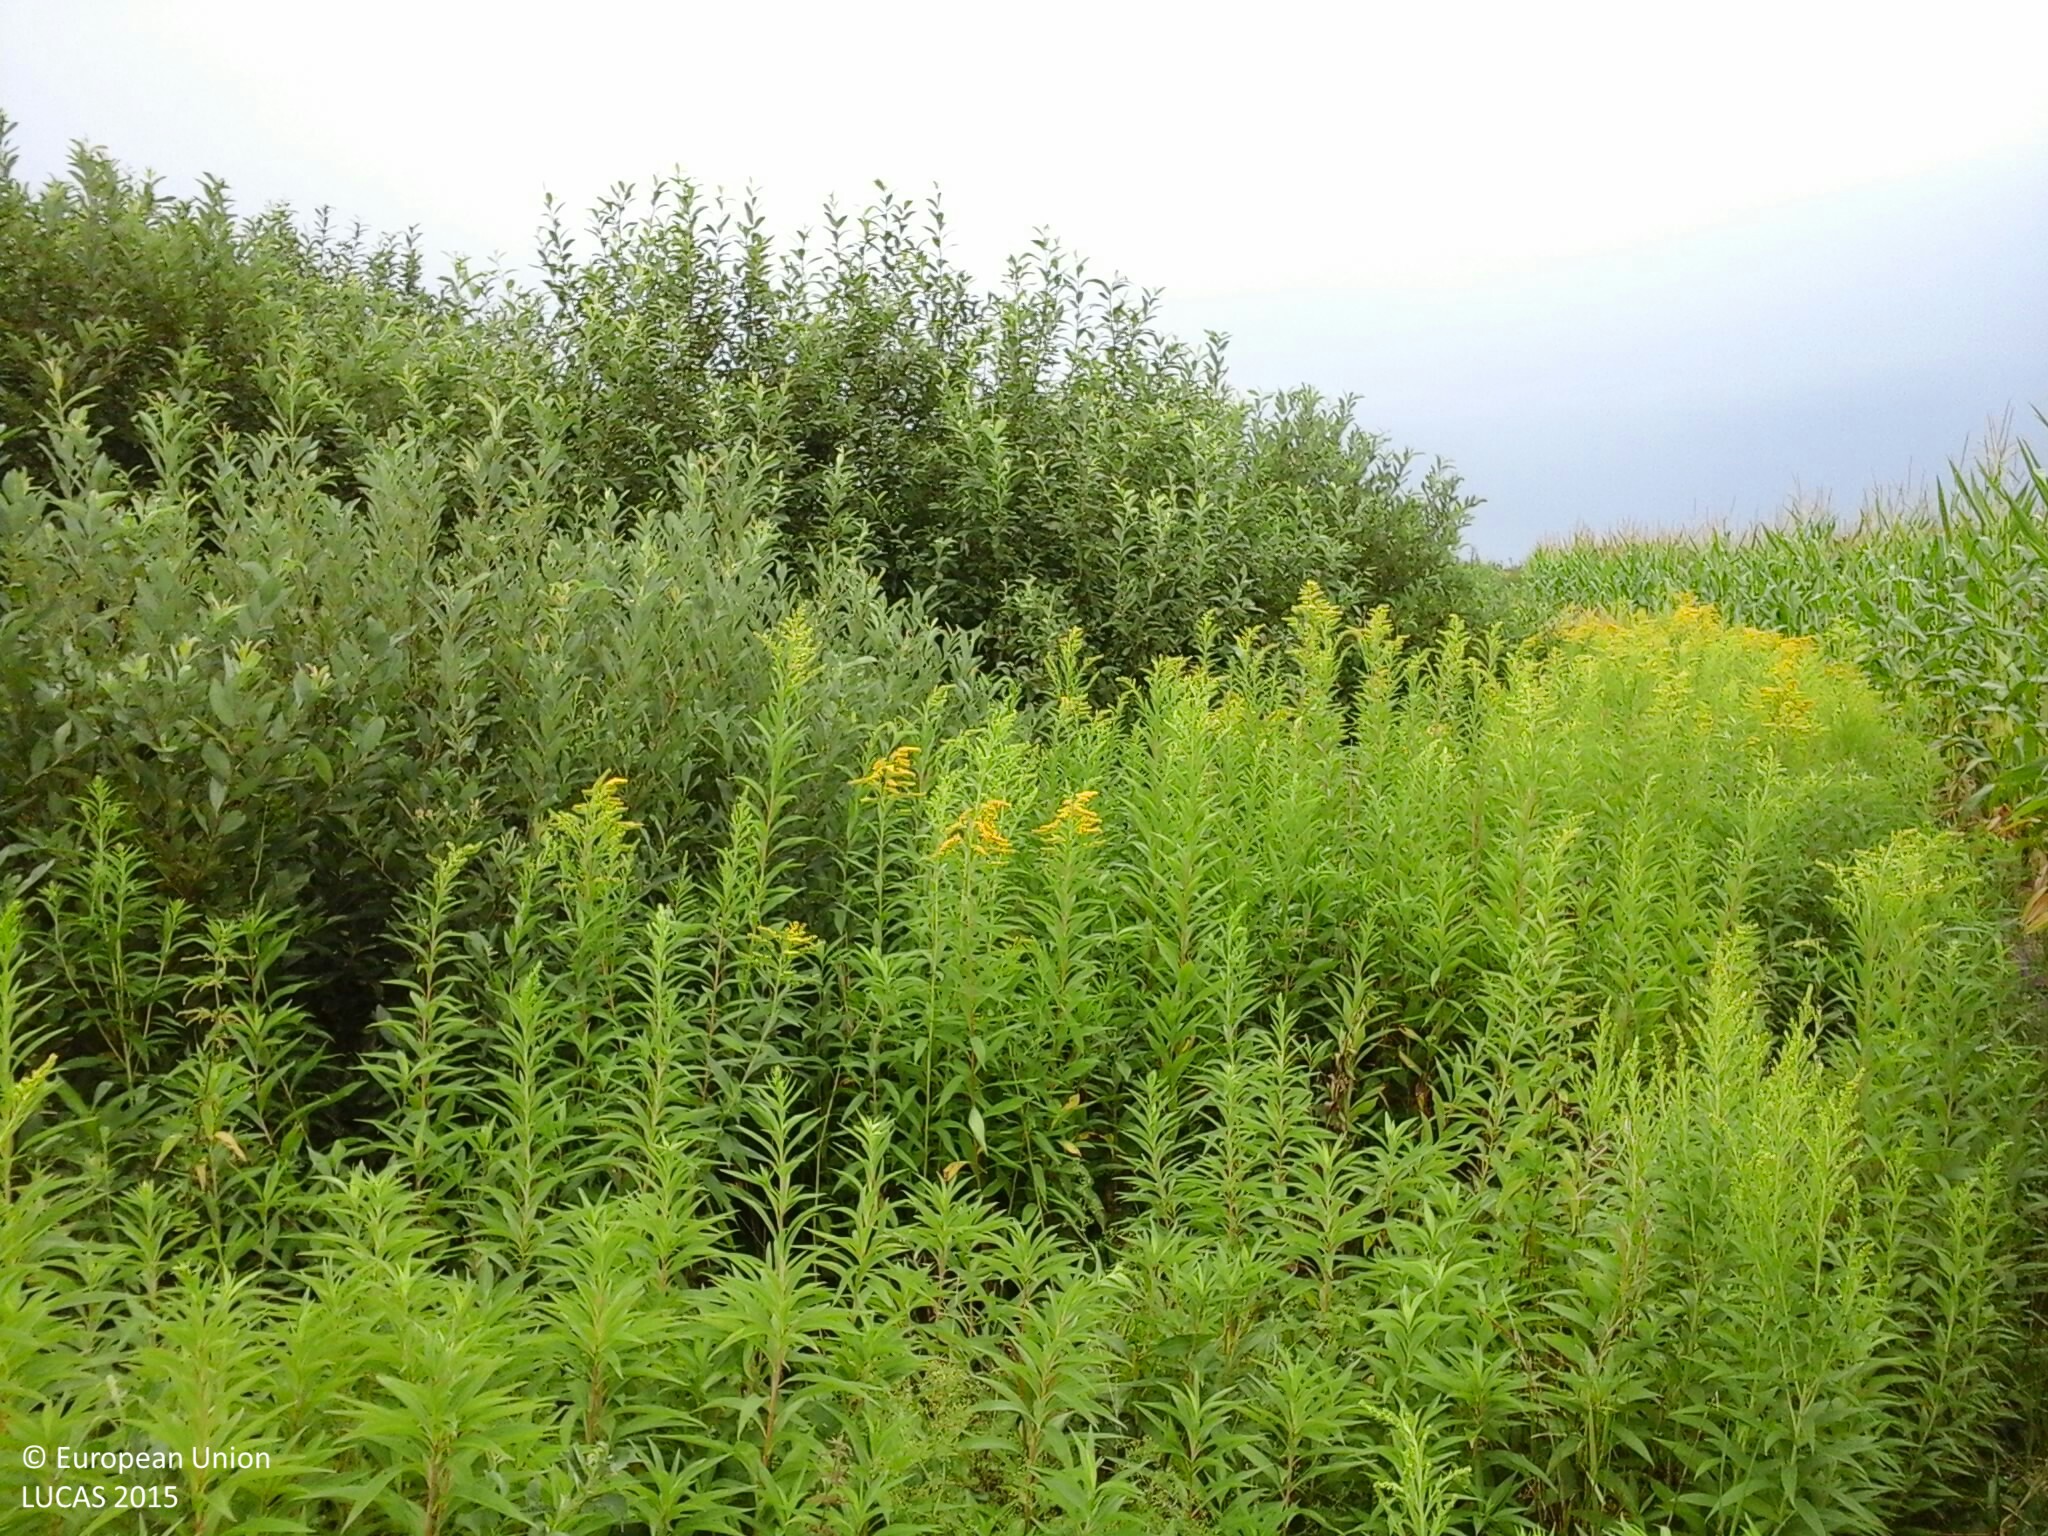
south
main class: Cropland
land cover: Maize
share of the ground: > 75 %
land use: Agriculture (excluding fallow land and kitchen gardens)
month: July
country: HU
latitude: 46.6463
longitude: 16.4164
